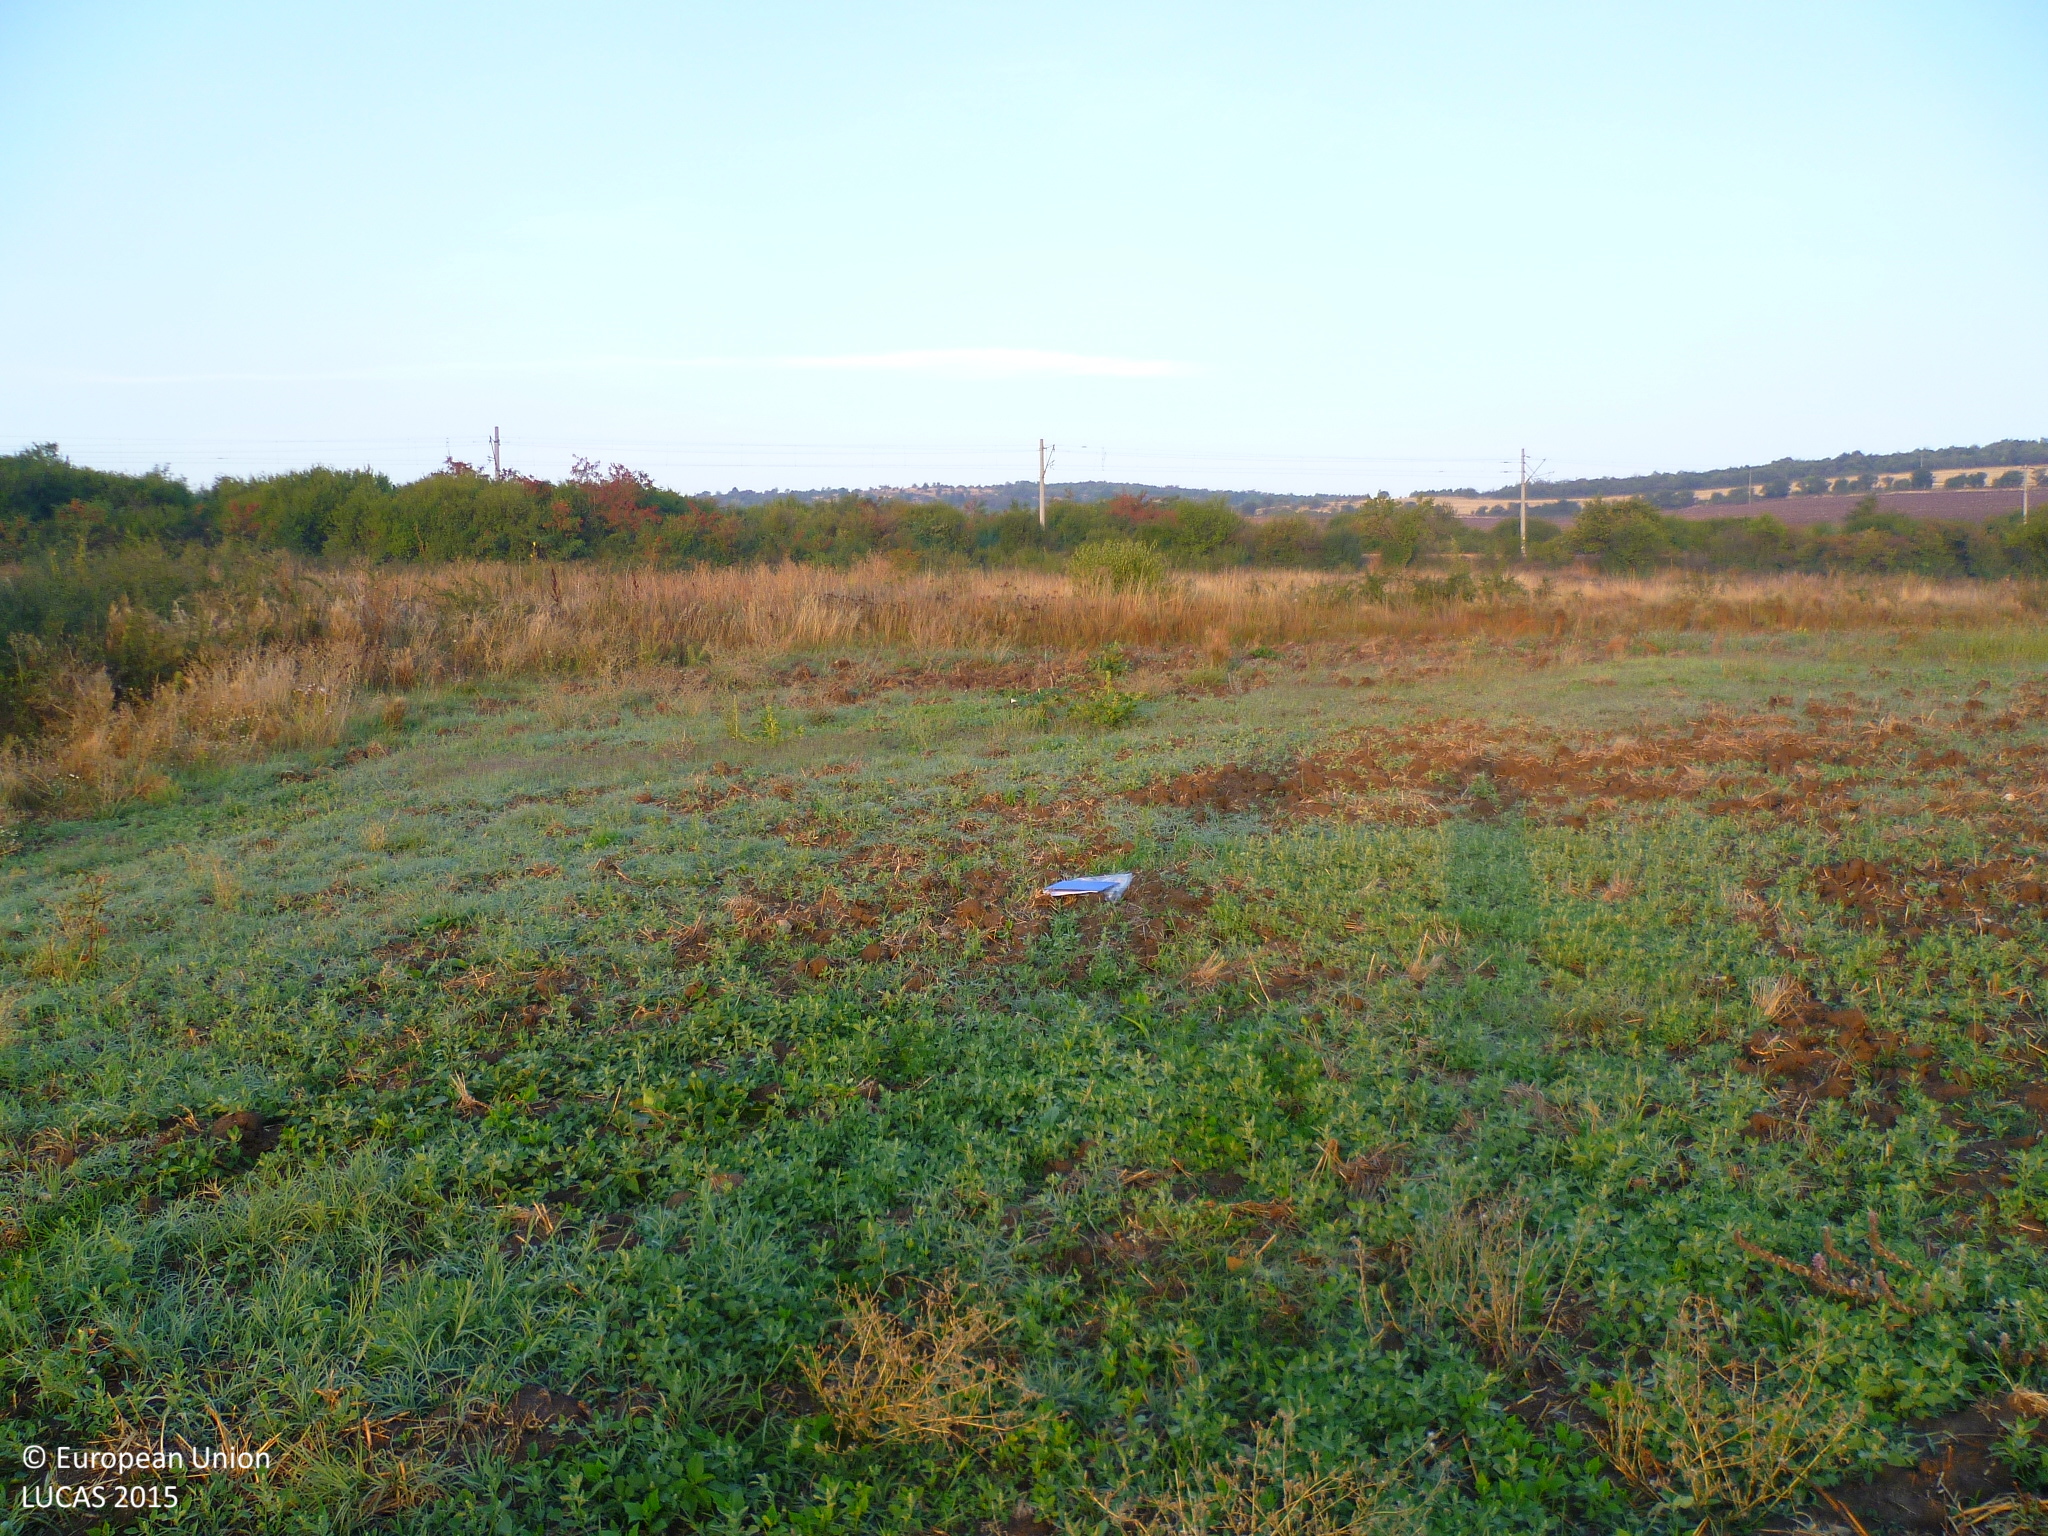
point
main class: Cropland
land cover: Rye
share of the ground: < 10 %
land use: Agriculture (excluding fallow land and kitchen gardens)
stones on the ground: < 10 %
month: September
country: BG
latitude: 42.8692
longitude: 23.0191
